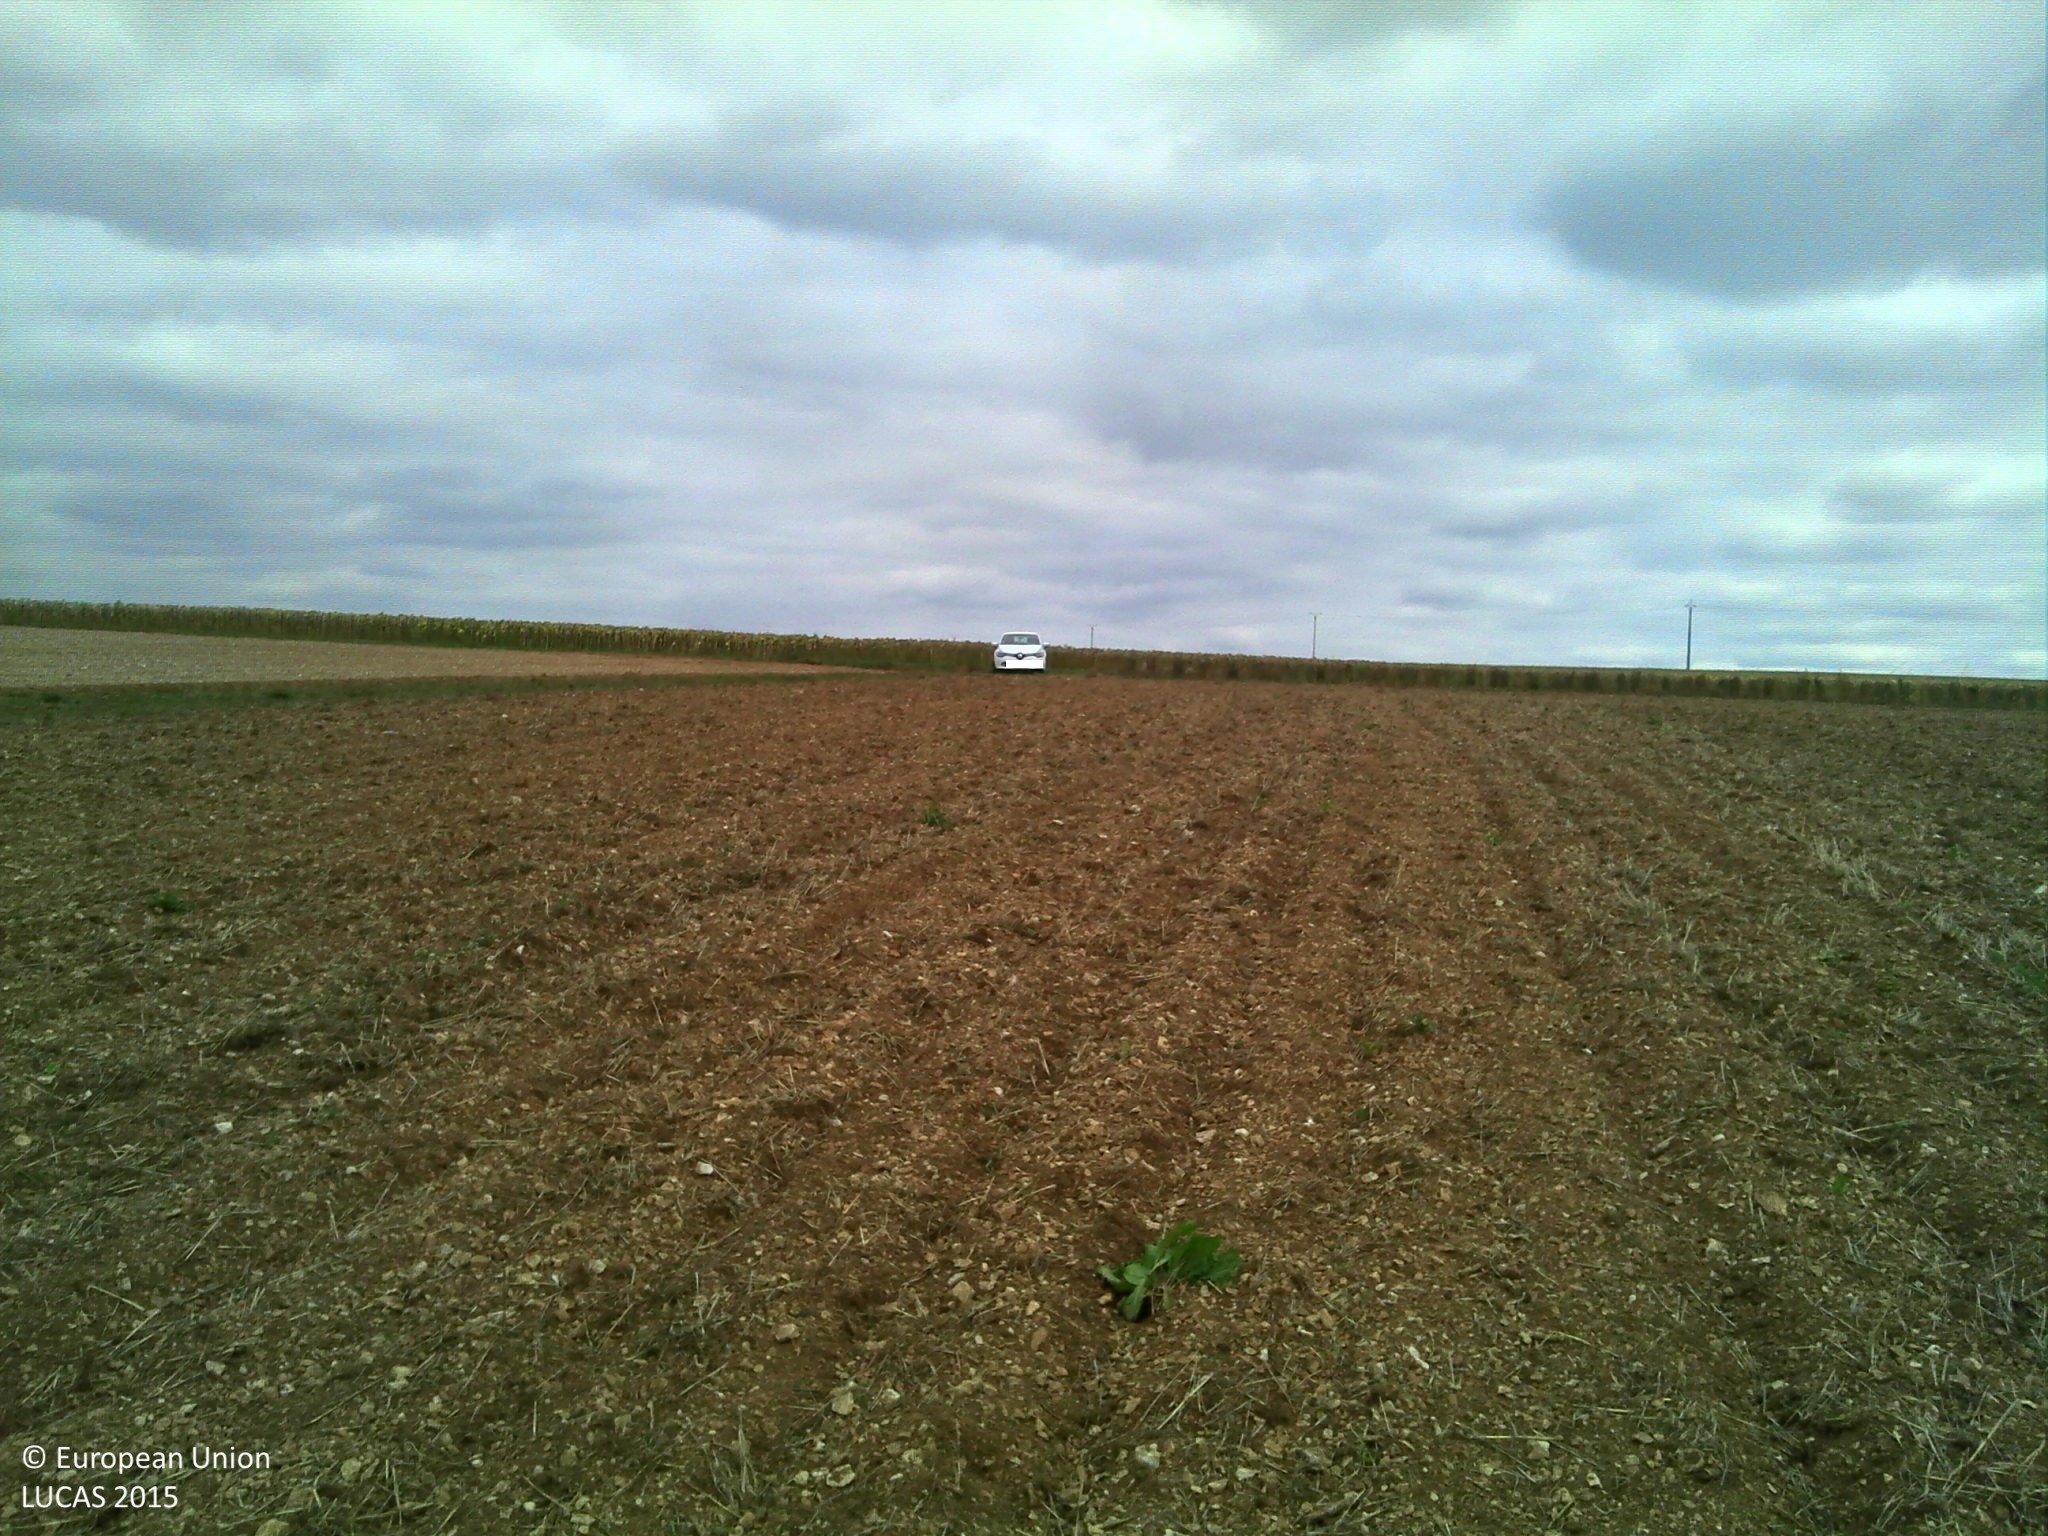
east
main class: Cropland
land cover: Common wheat
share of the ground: 10 - 25 %
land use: Agriculture (excluding fallow land and kitchen gardens)
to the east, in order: Common wheat; Managed hedges; Grass margins; Paved roads, cycling and walking lanes; Grass margins; Other bare soil; Sunflower; Other cereals; Other fibre and oleaginous crops
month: September
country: FR
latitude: 47.5741
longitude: 4.7217
